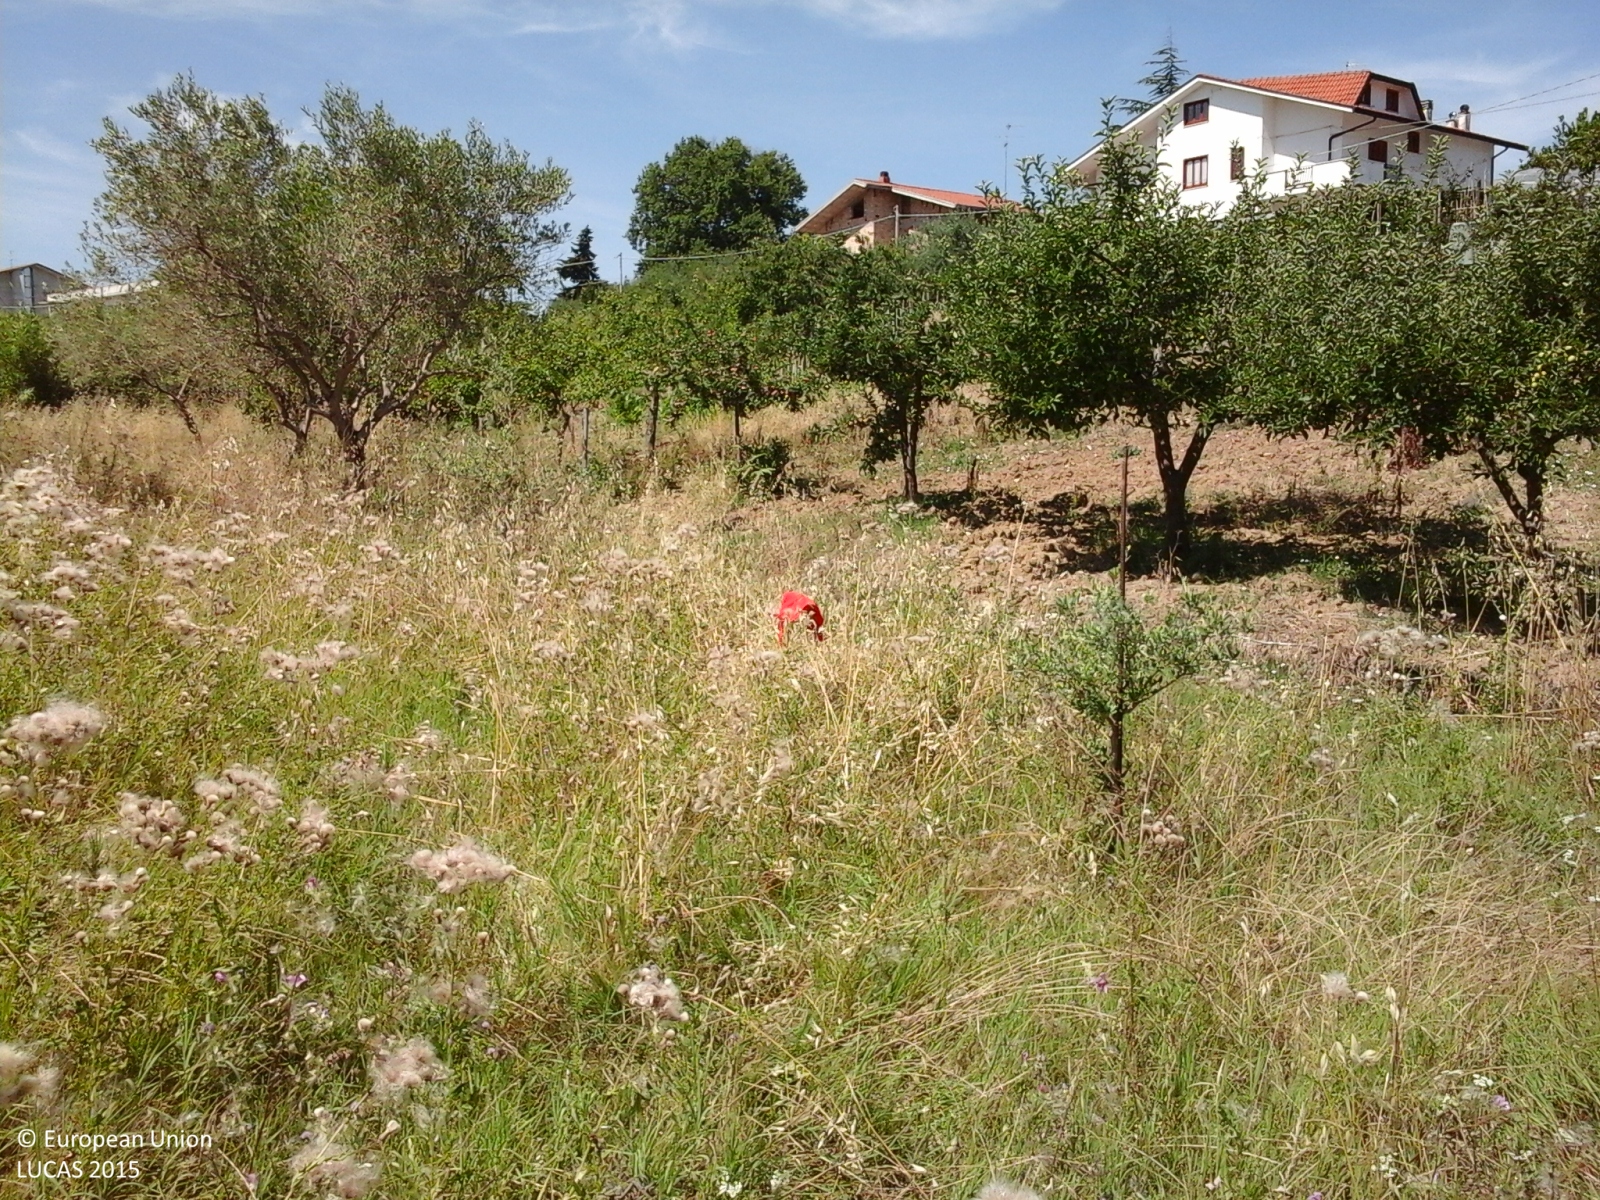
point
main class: Cropland
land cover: Olive groves
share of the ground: 25 - 50 %
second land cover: Spontaneously vegetated surfaces
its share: > 75 %
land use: Agriculture (excluding fallow land and kitchen gardens)
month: June
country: IT
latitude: 42.2685
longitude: 14.4119
